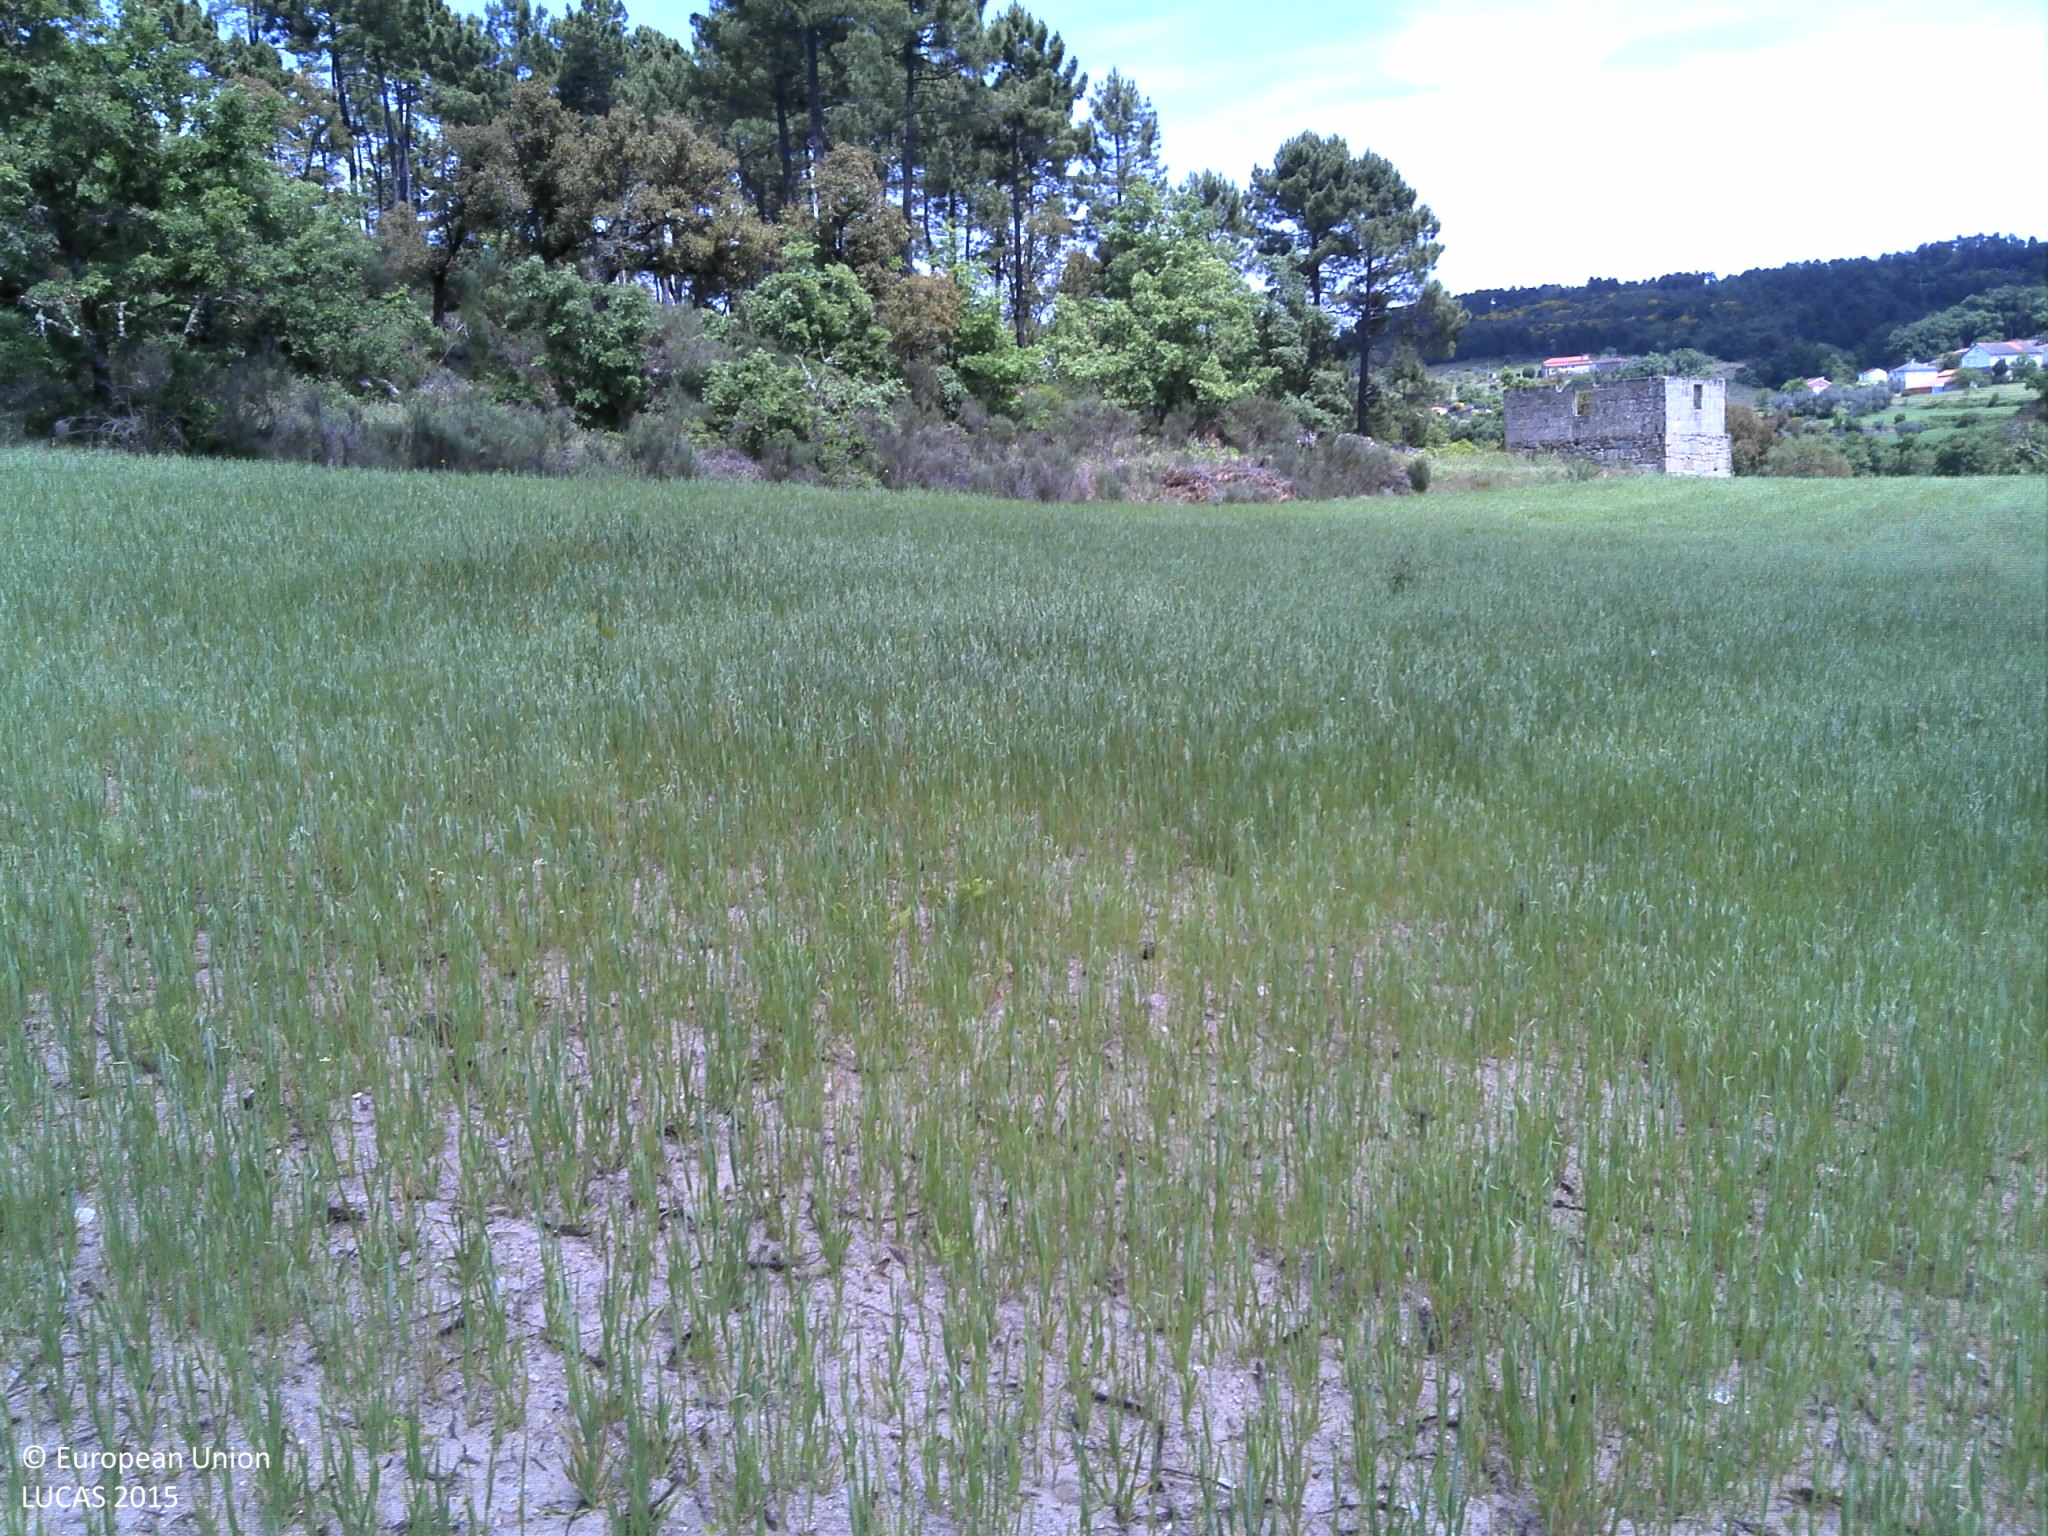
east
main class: Cropland
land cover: Oats
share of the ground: 25 - 50 %
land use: Agriculture (excluding fallow land and kitchen gardens)
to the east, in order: Oats; Ditches and canals; Spontaneously vegetated surfaces; Artificial constructions in urban areas; Oats; Abandoned hedges; Dry stone walls; Tracks; Grass margins; Dry stone walls; Groves; Spontaneously vegetated surfaces; Dry stone walls; Tracks; Dry stone walls; Vineyards; Spontaneously vegetated surfaces; Broadleaved woodland; Shrubland with sparse tree cover
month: May
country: PT
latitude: 41.6988
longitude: -7.5431
